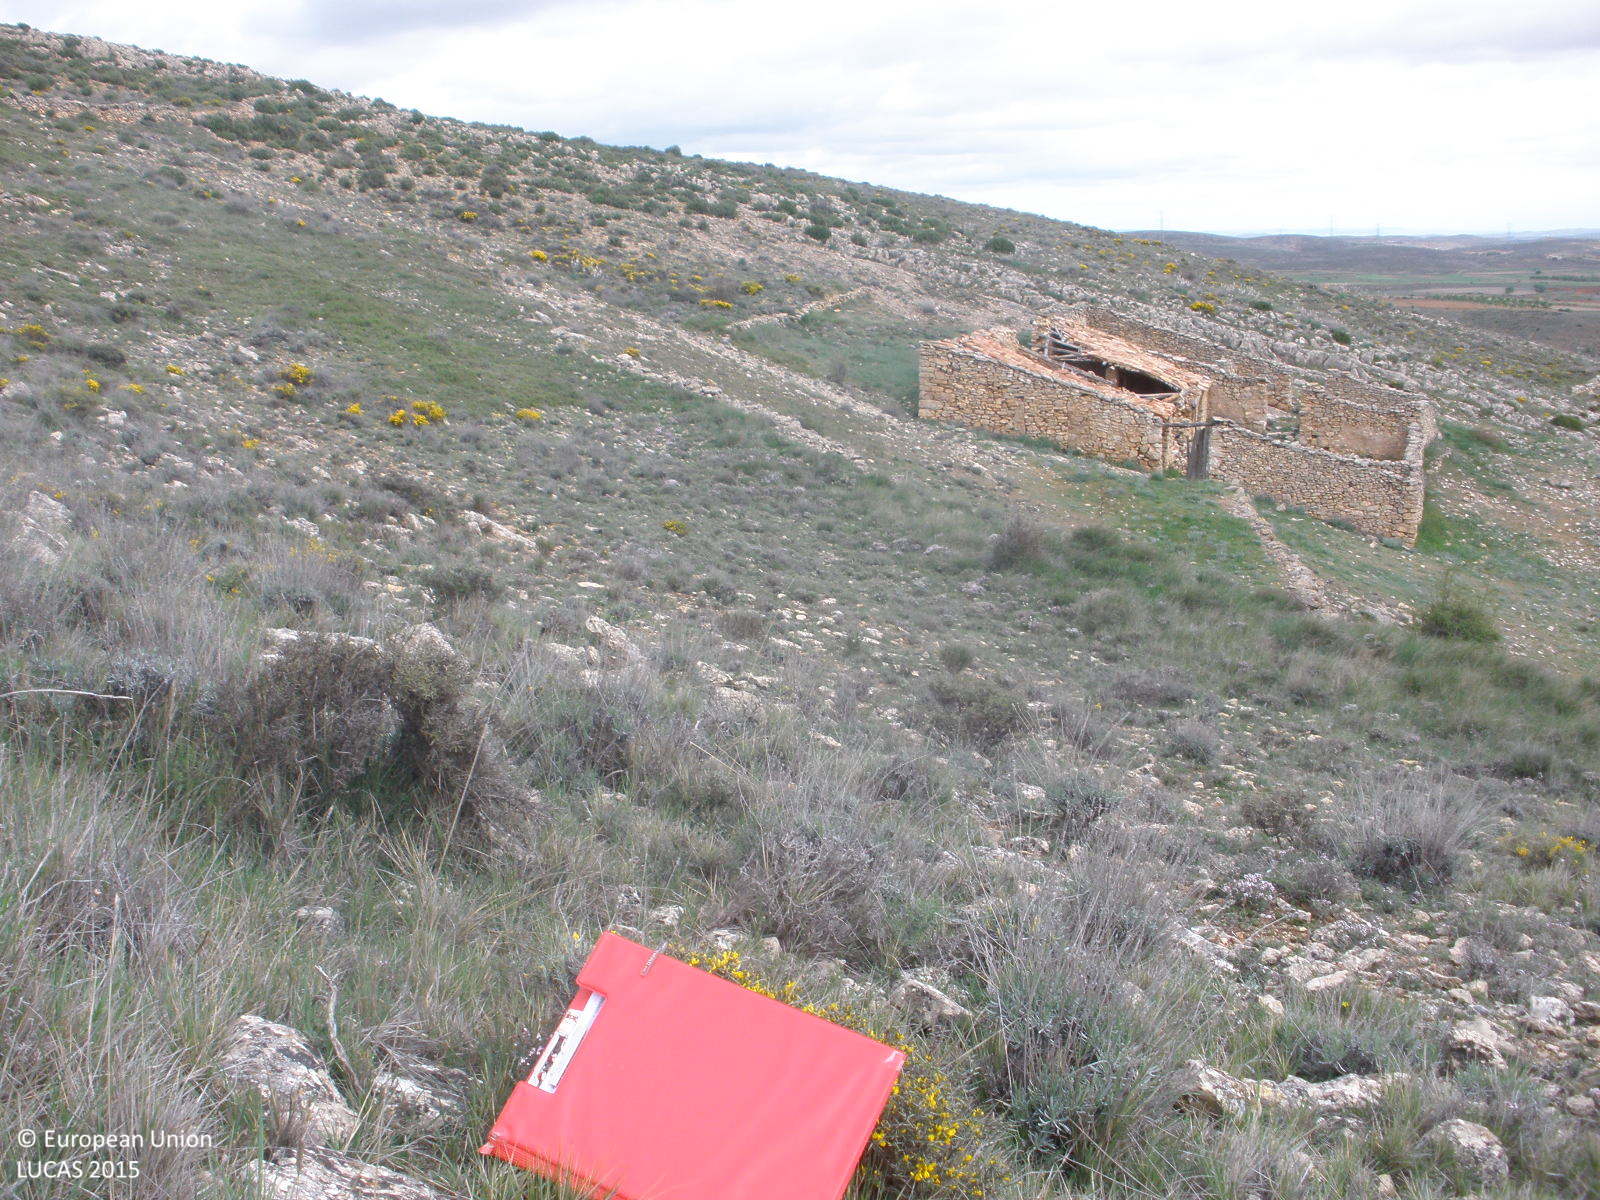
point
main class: Shrubland
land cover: Shrubland without tree cover
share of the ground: 50 - 75 %
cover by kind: shrubs 60 %, herbaceous plants 30 %, consolidated bare surface 10 %
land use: Semi-natural and natural areas not in use
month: May
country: ES
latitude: 40.9391
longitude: -0.8591
